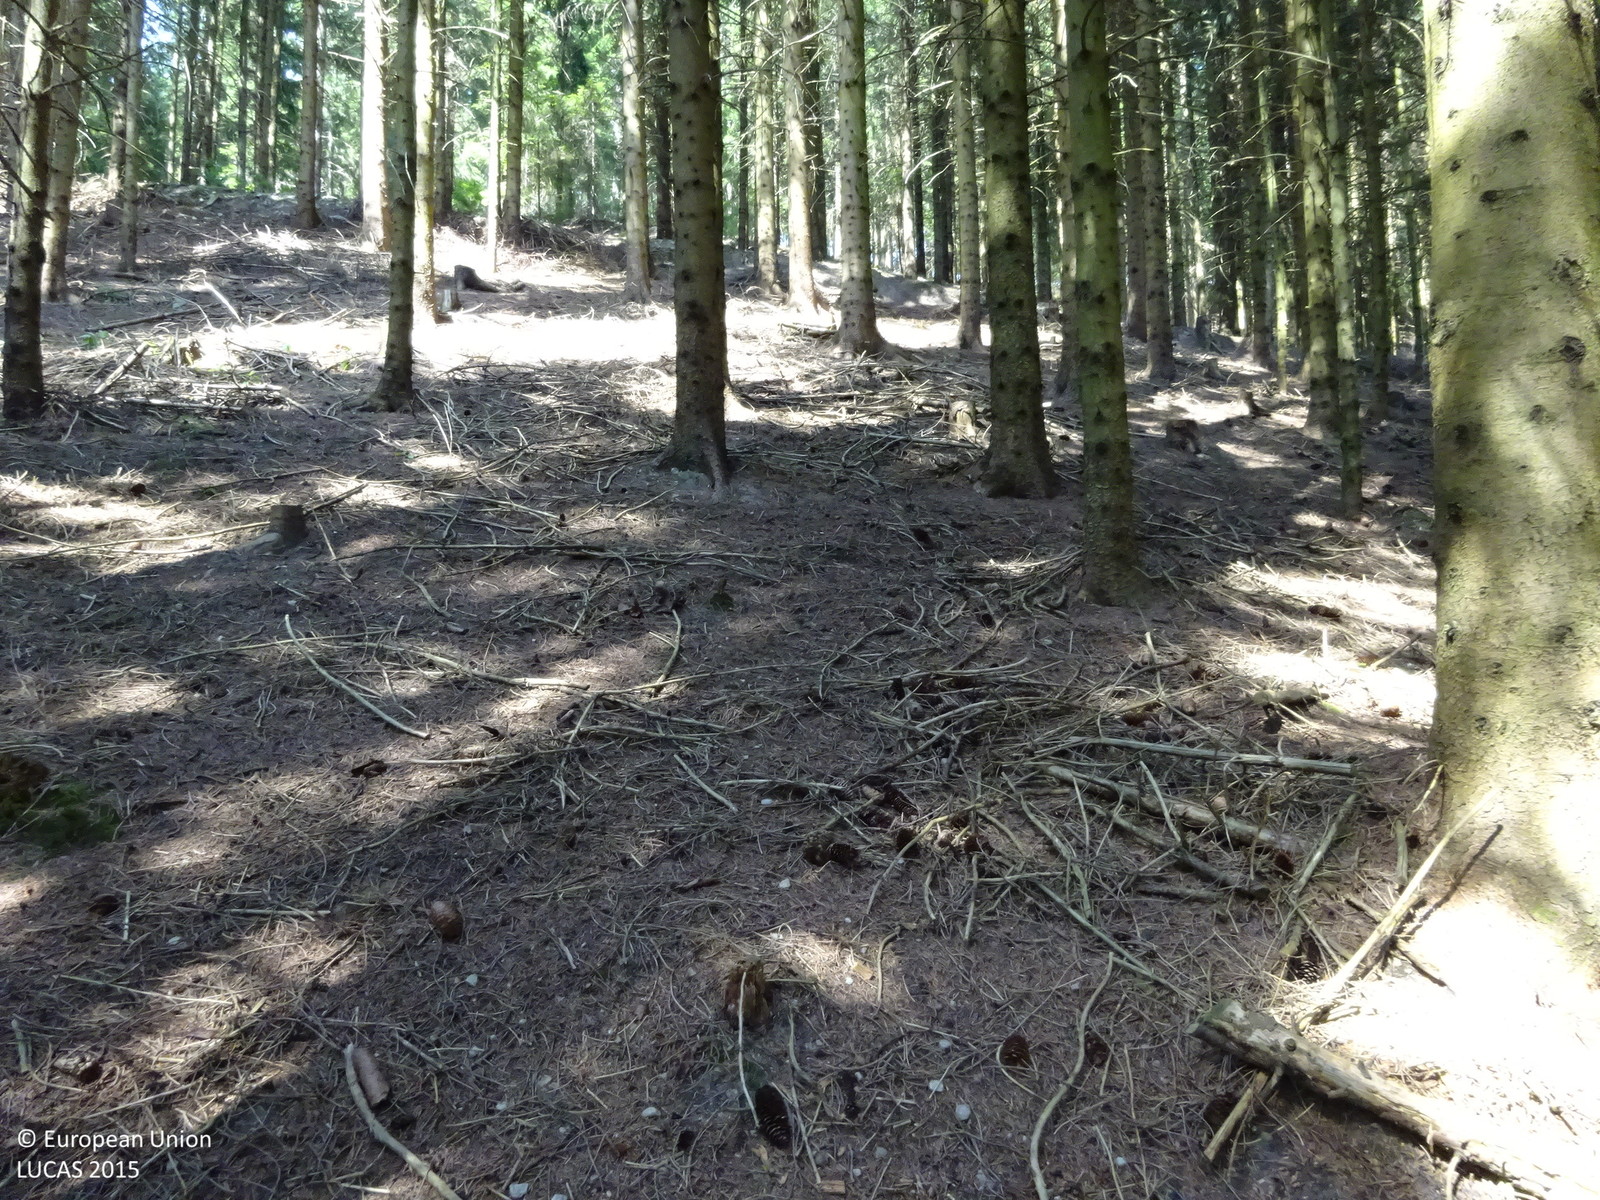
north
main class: Woodland
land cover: Spruce dominated coniferous woodland
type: alpine coniferous forest
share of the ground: > 75 %
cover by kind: coniferous forest trees 100 %
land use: Forestry
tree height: > 5 m
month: August
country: AT
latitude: 47.4589
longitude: 15.7717
